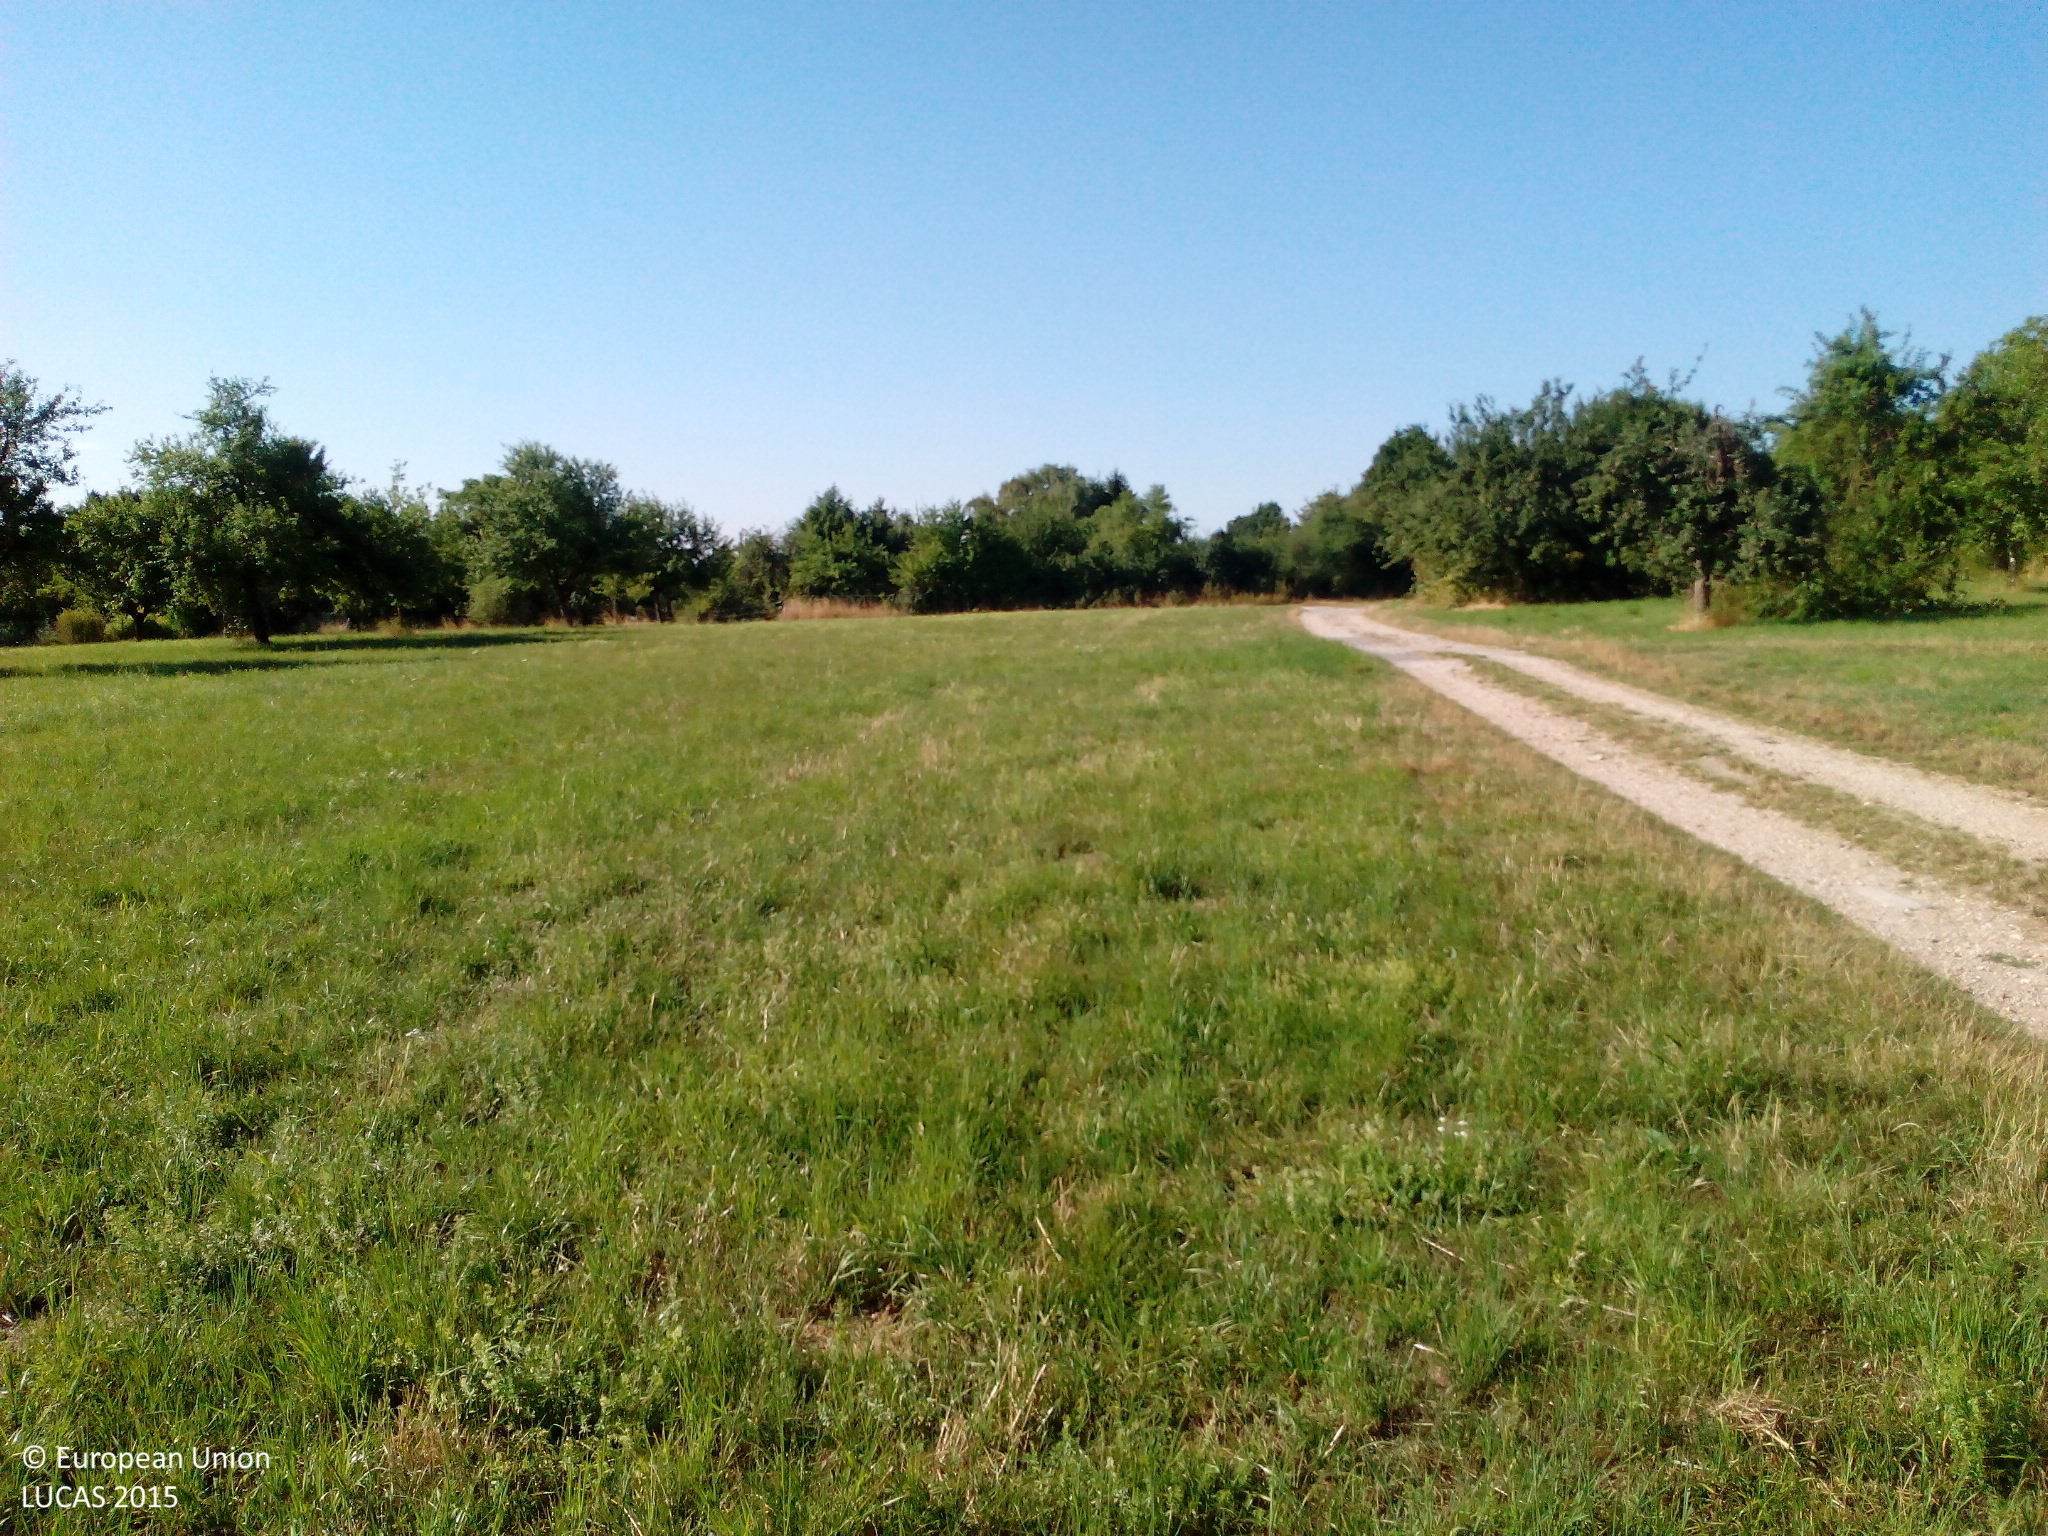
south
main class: Grassland
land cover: Grassland without tree/shrub cover
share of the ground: > 75 %
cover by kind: herbaceous plants 90 %, unconsolidated bare surface 10 %
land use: Agriculture (excluding fallow land and kitchen gardens)
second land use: Amenities, museums, leisure
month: July
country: DE
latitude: 50.1017
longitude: 8.4485
